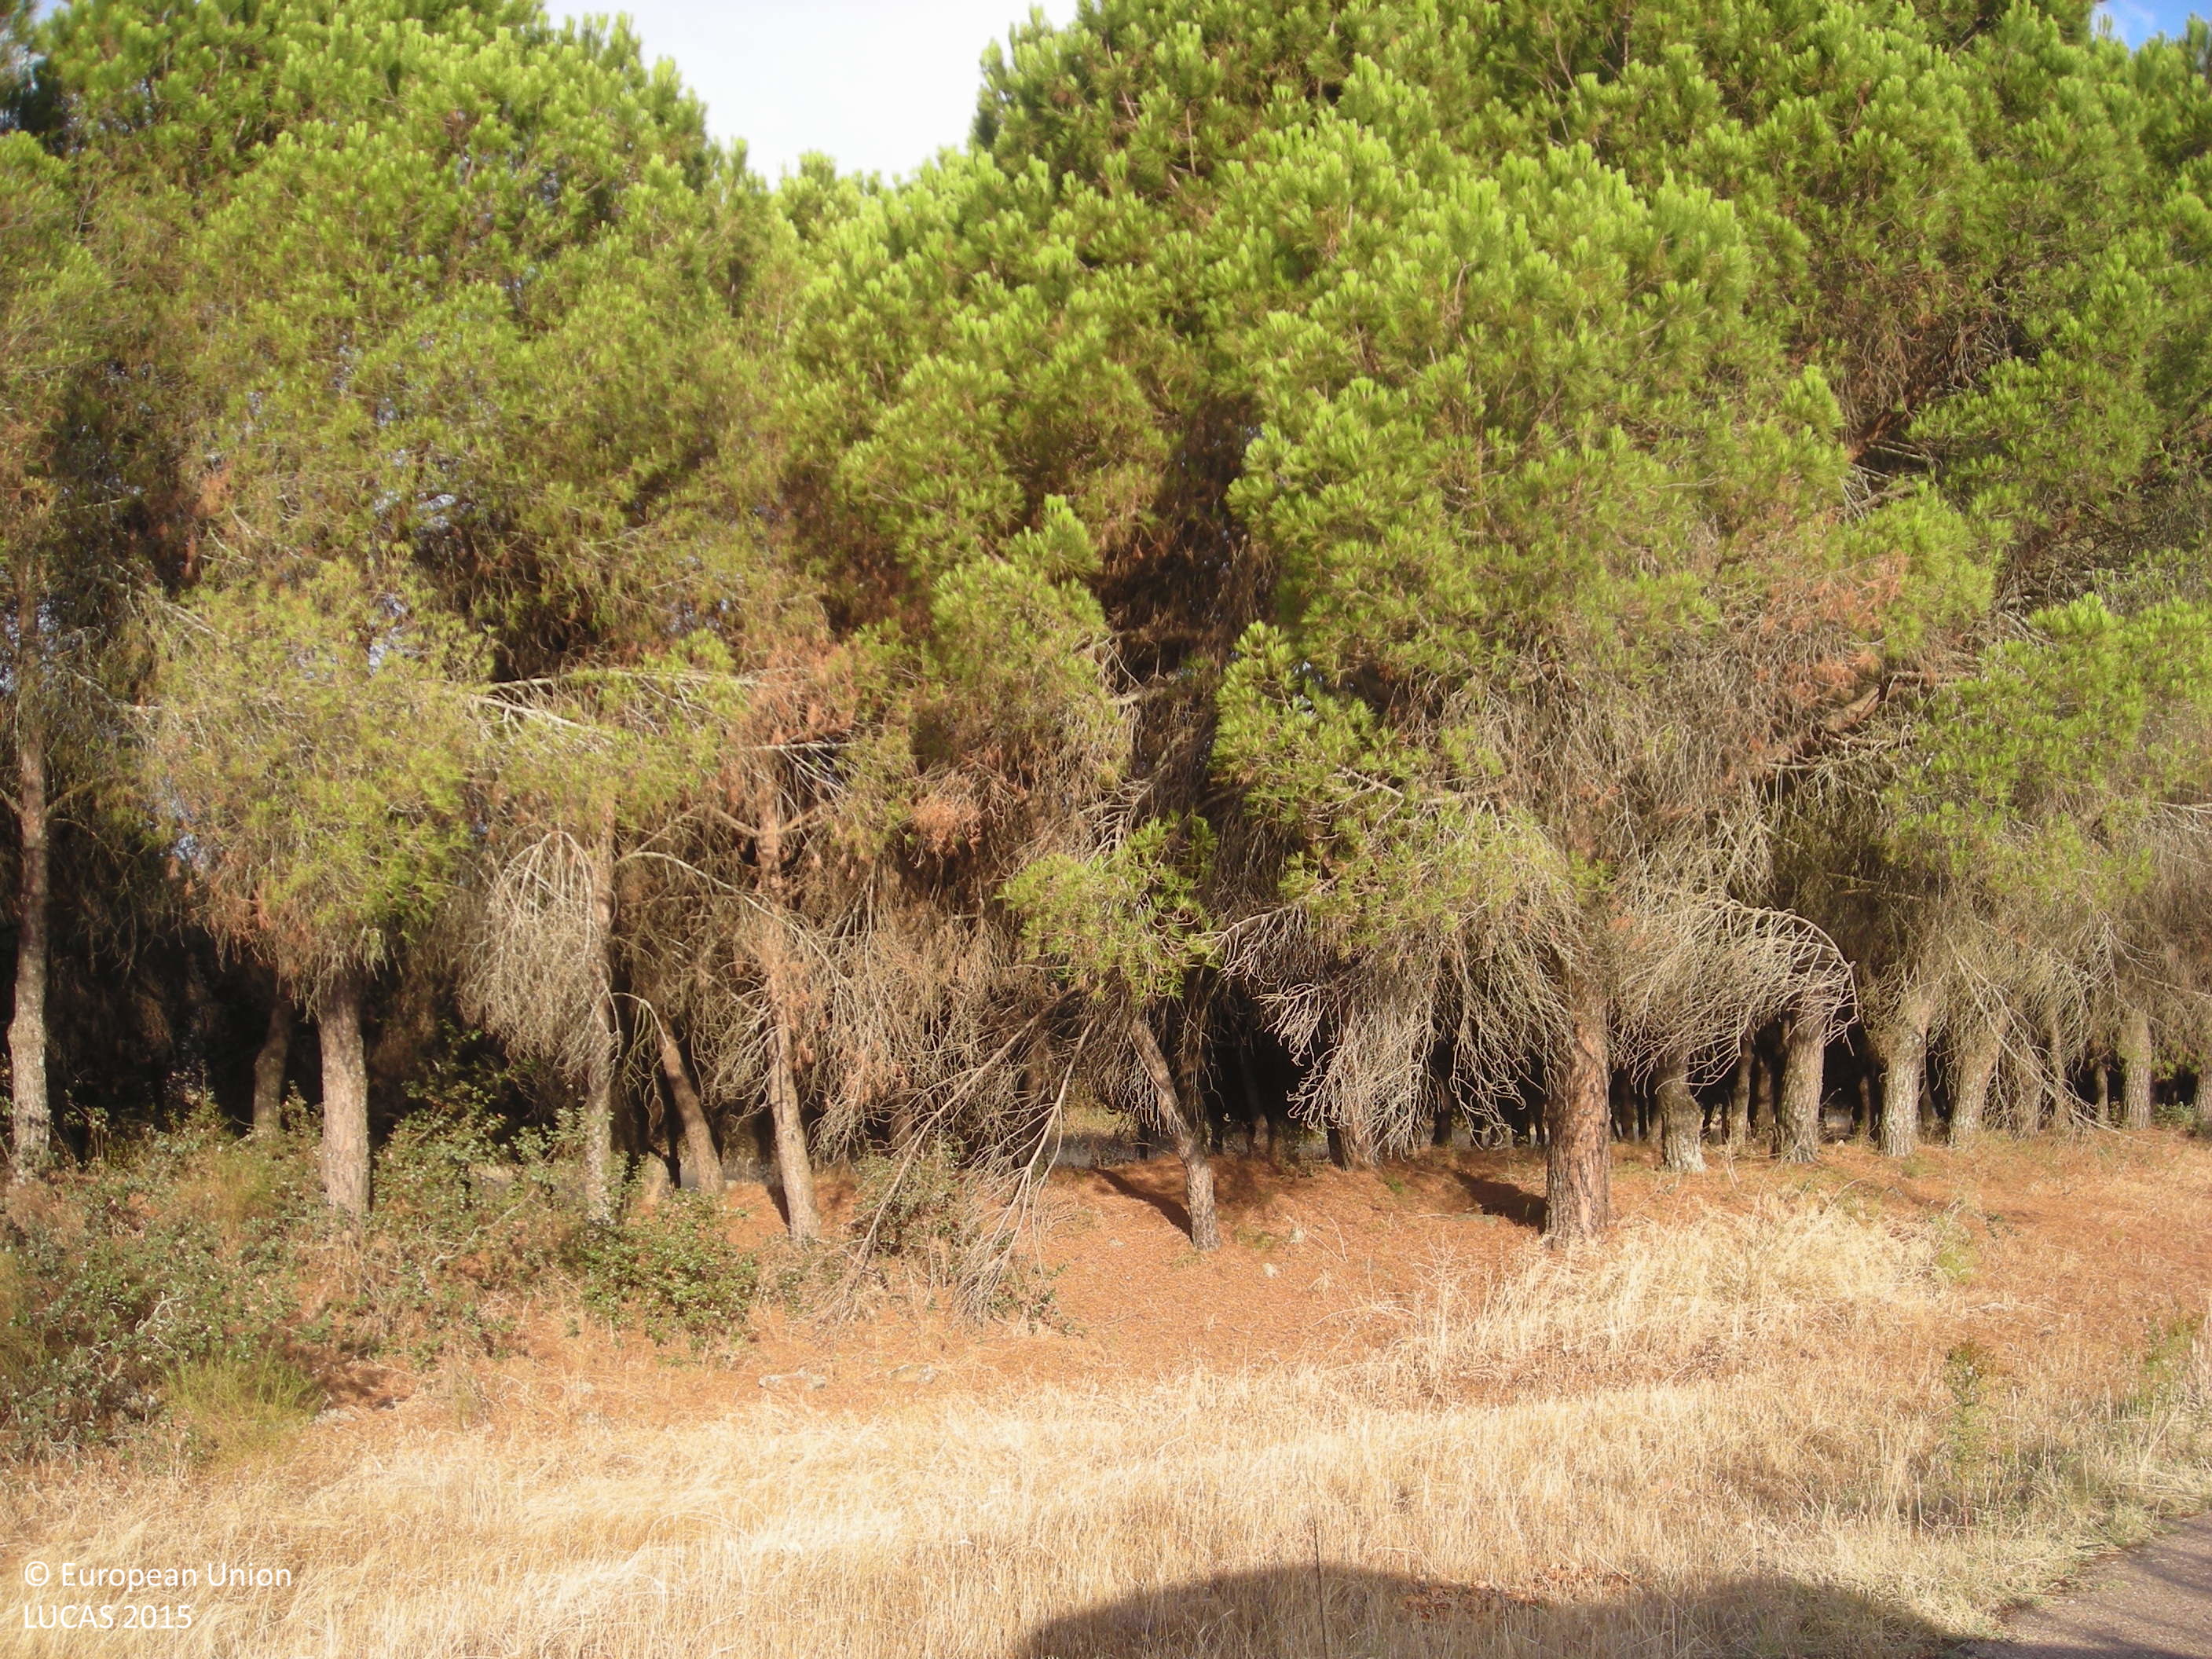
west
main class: Woodland
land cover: Broadleaved woodland
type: broadleaved evergreen forest
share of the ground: 50 - 75 %
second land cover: Grassland without tree/shrub cover
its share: 50 - 75 %
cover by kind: broadleaved forest trees 60 %, herbaceous plants 40 %
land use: Forestry
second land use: Agriculture (excluding fallow land and kitchen gardens)
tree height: > 5 m
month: July
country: ES
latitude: 39.1491
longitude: -5.9882
